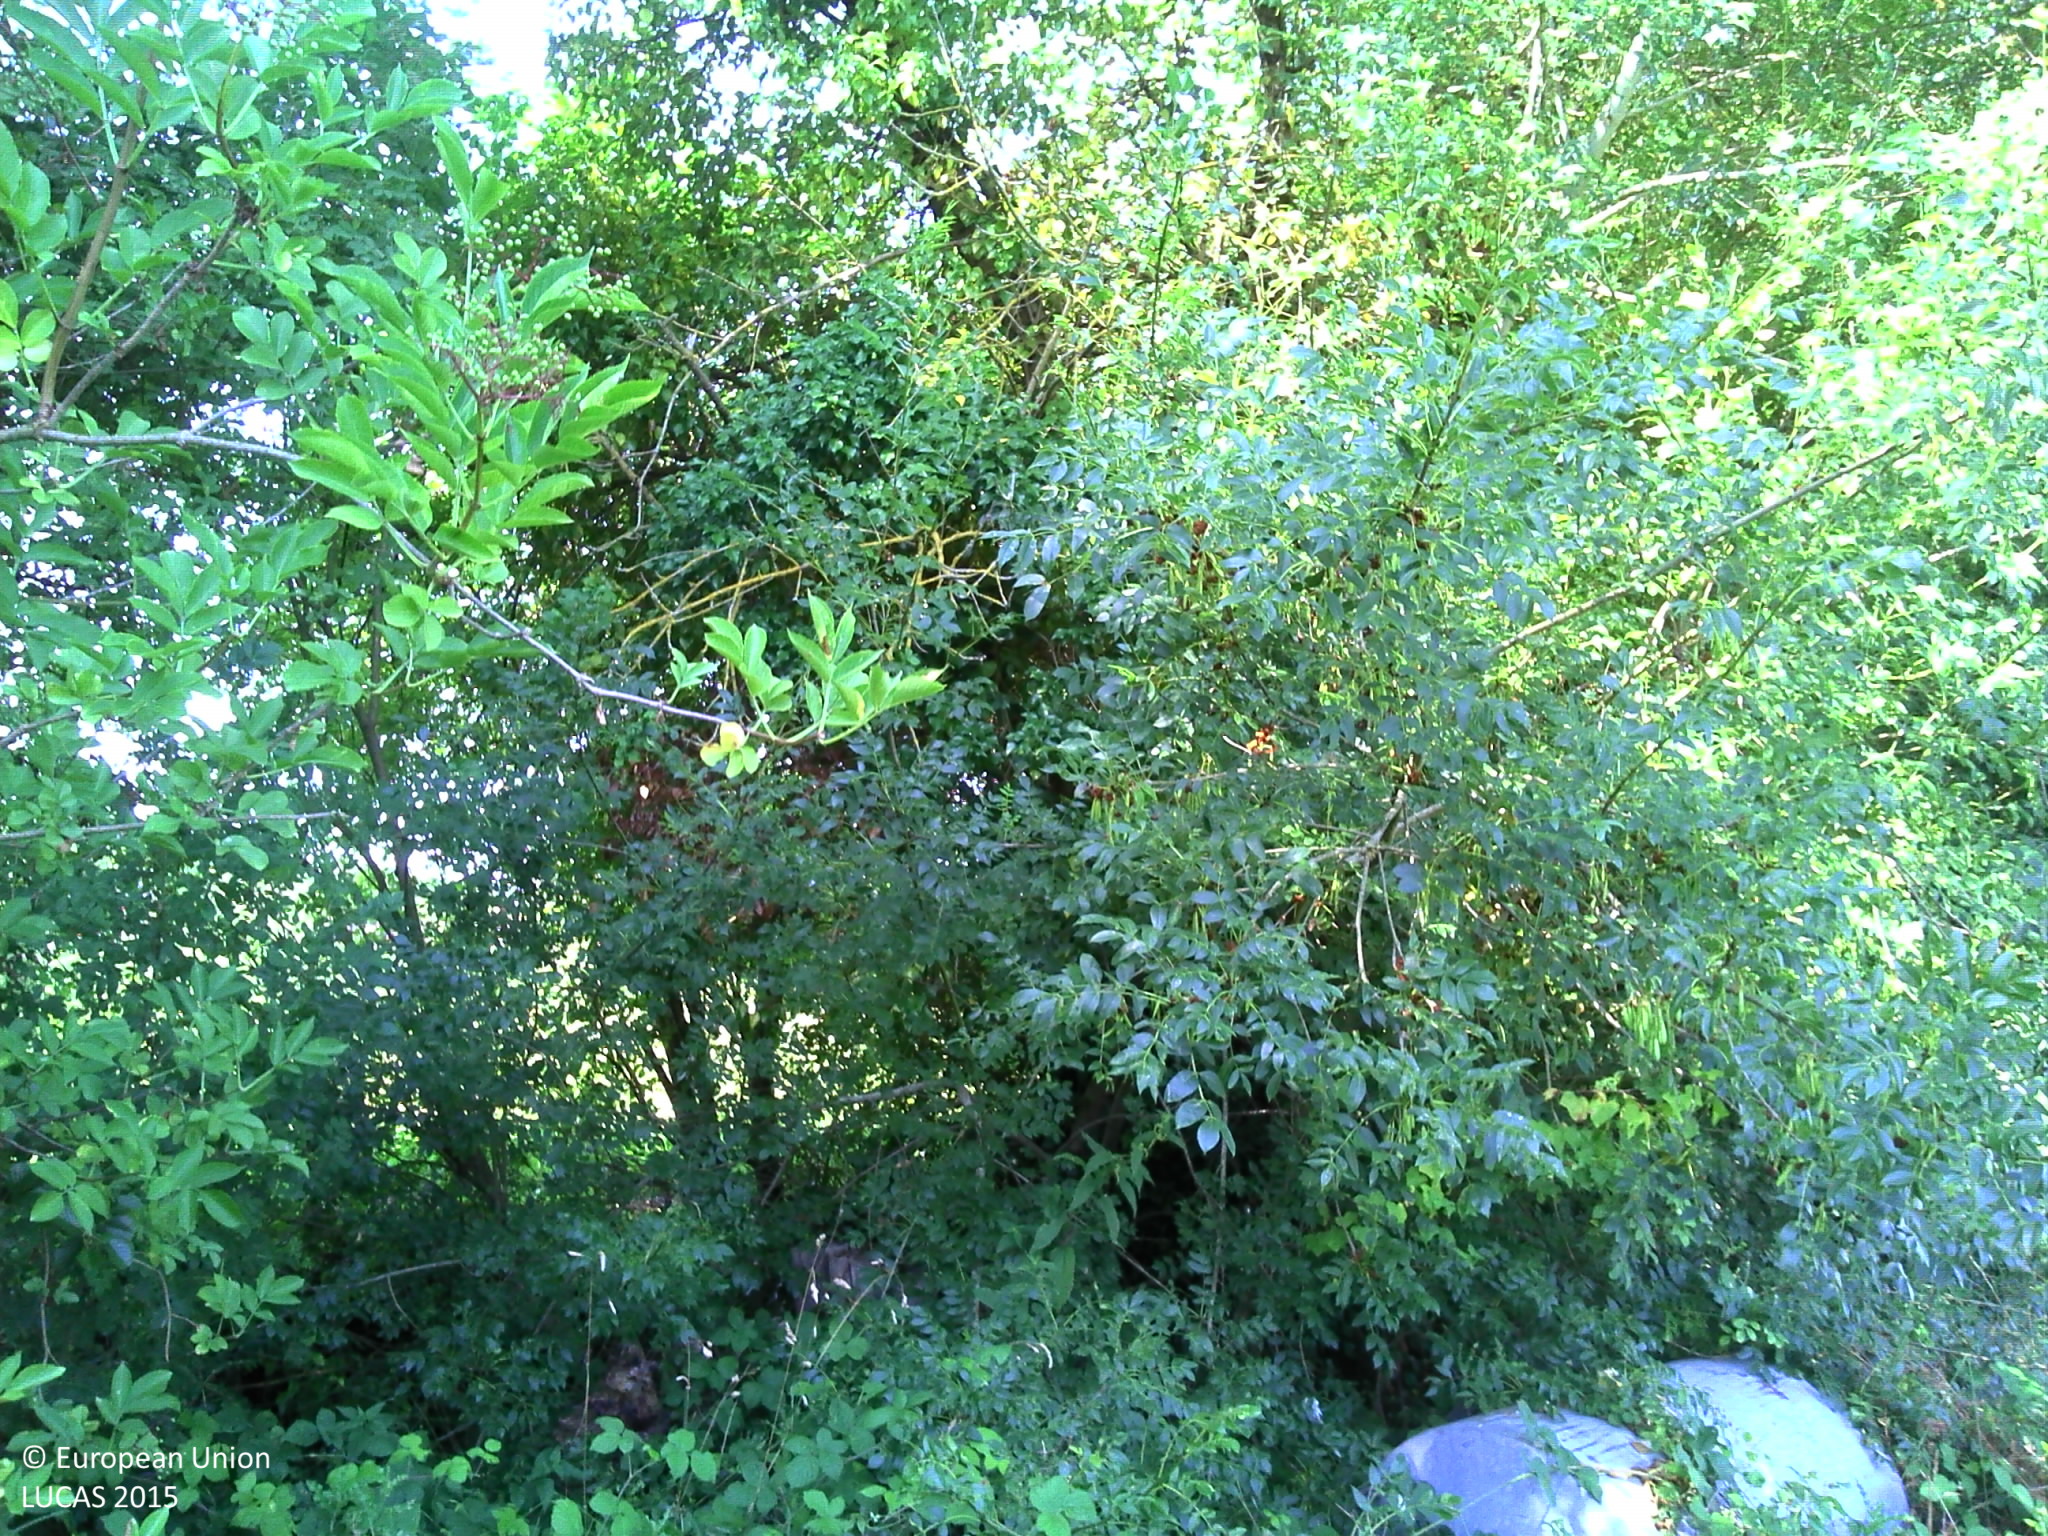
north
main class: Woodland
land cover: Broadleaved woodland
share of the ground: > 75 %
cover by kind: herbaceous plants 70 %, broadleaved forest trees 30 %
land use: Semi-natural and natural areas not in use
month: July
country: FR
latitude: 47.7100
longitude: -0.0367
